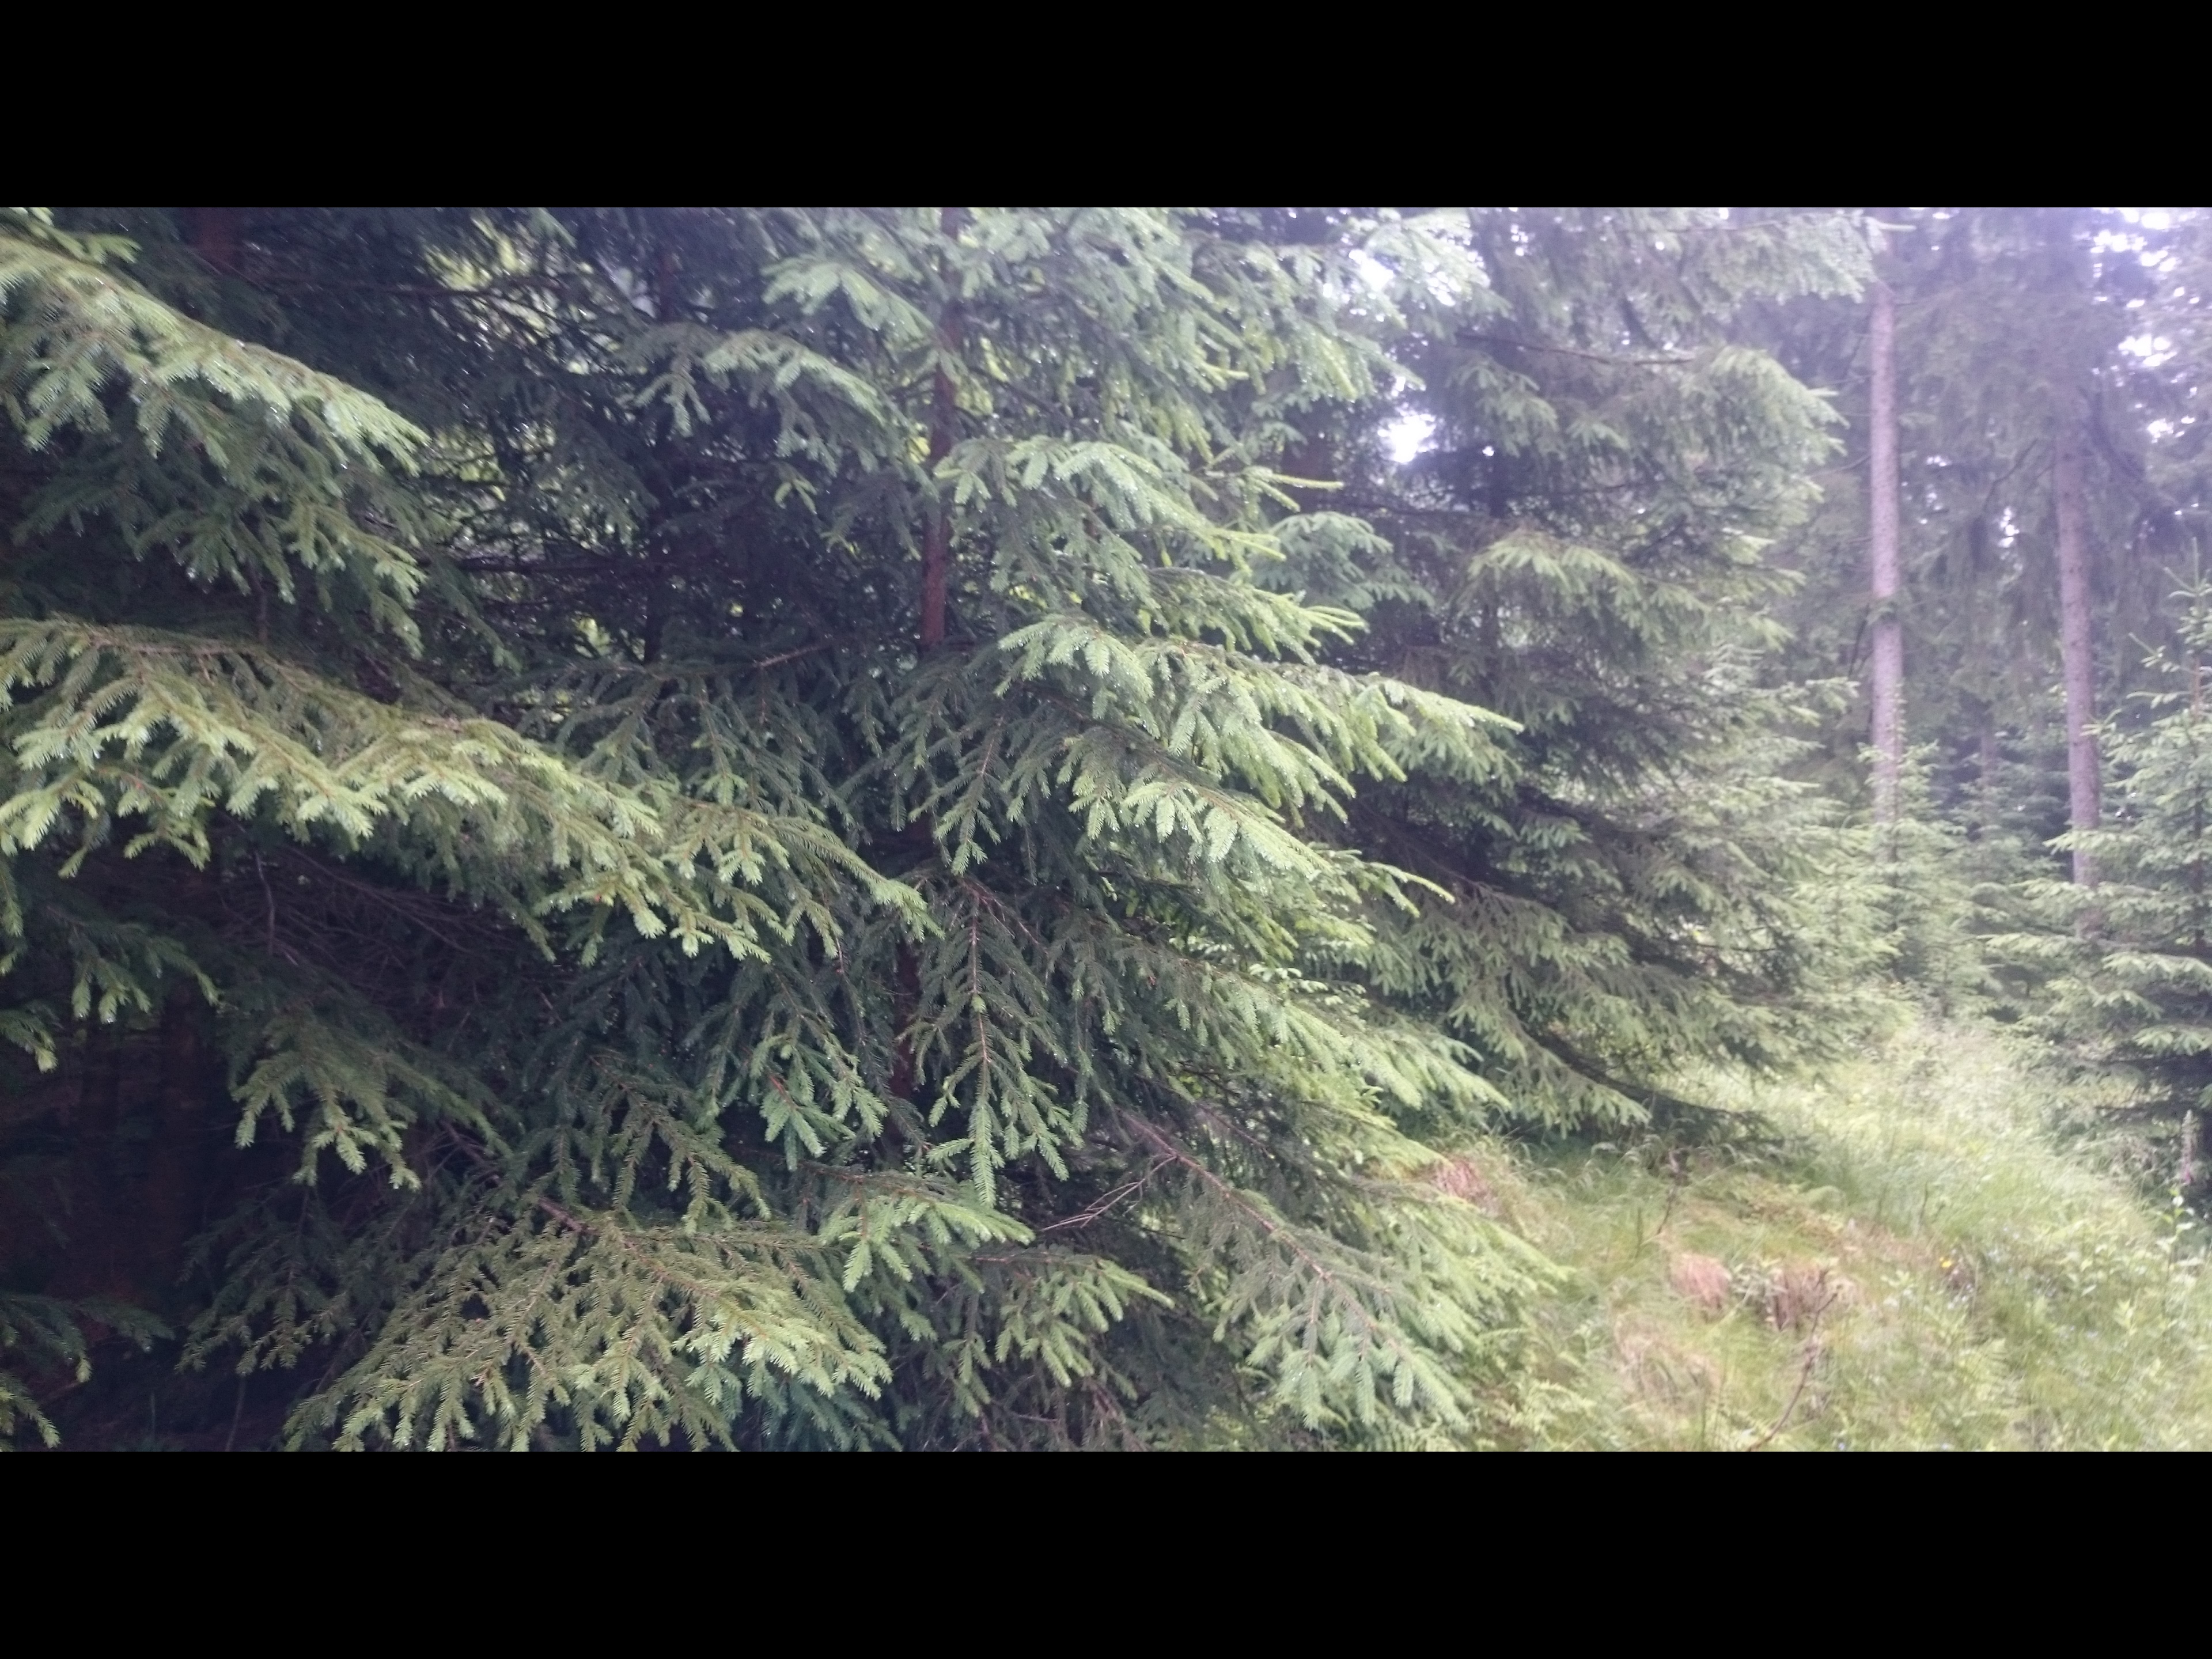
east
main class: Woodland
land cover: Spruce dominated coniferous woodland
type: hemiboreal forest and nemoral coniferous forest and mixed broadleaved-coniferous forest
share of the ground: > 75 %
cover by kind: coniferous forest trees 80 %, shrubs 10 %, unconsolidated bare surface 10 %
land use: Forestry
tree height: > 5 m
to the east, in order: Spruce dominated coniferous woodland; Tracks; Spruce dominated coniferous woodland; Tracks; Spruce dominated coniferous woodland; Tracks; Spruce dominated coniferous woodland; Grass margins; Tracks; Grass margins; Spruce dominated coniferous woodland
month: June
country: AT
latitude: 48.5940
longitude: 14.6517
